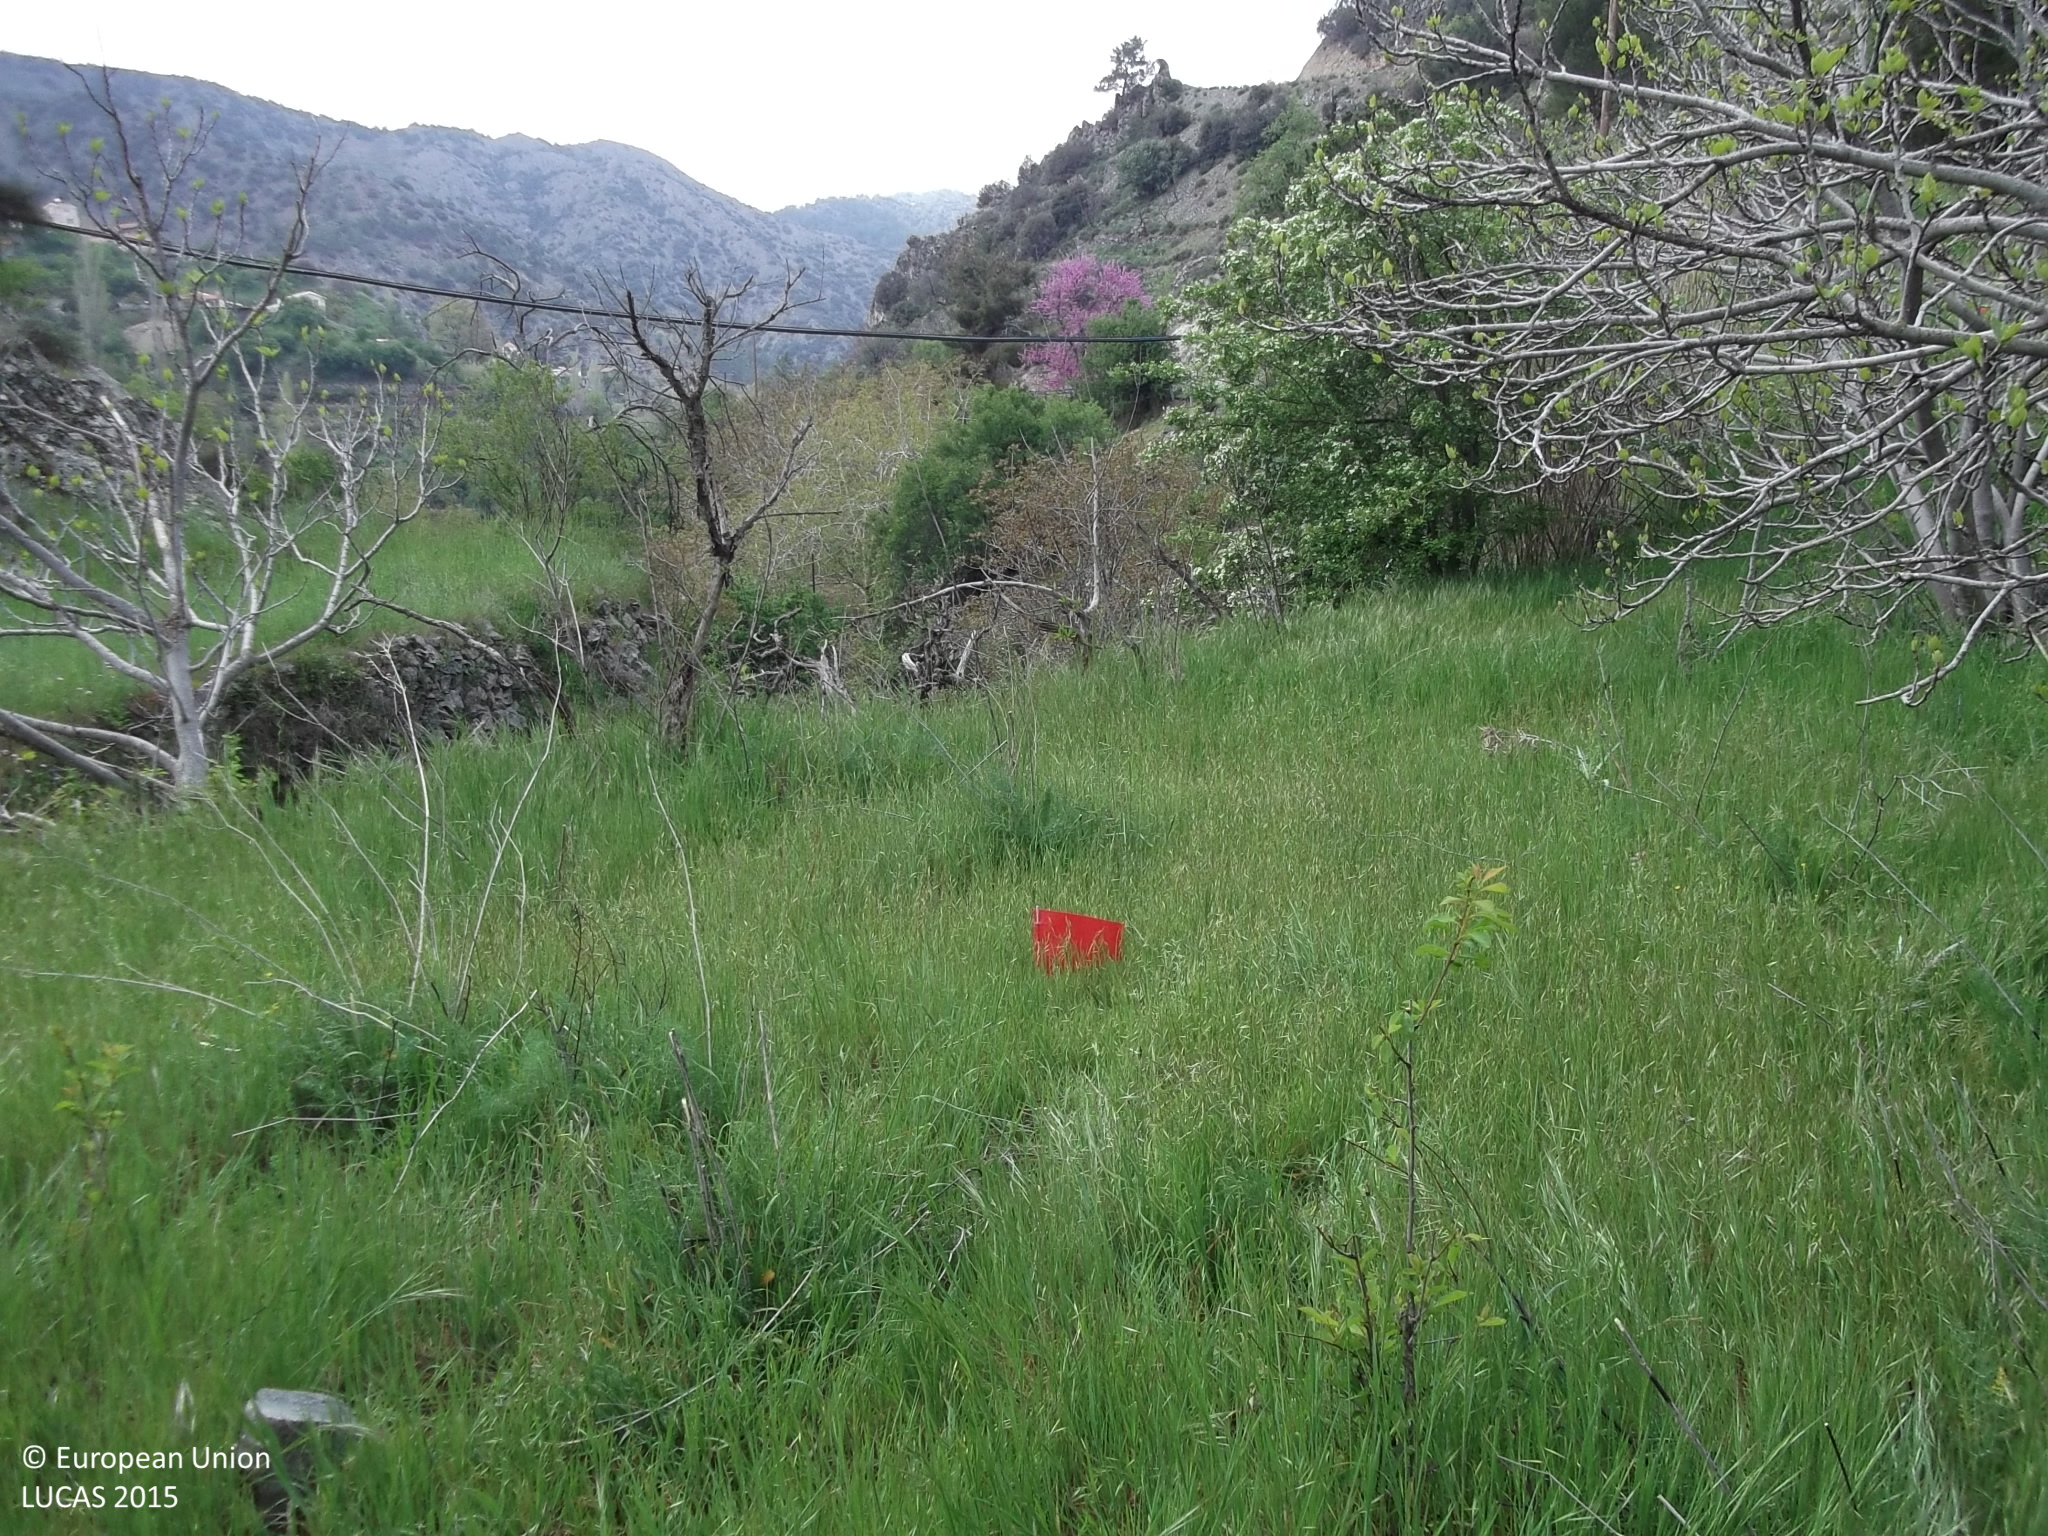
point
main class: Cropland
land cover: Other fruit trees and berries
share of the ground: 10 - 25 %
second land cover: Grassland without tree/shrub cover
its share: > 75 %
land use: Agriculture (excluding fallow land and kitchen gardens)
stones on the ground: 25 - 50 %
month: April
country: CY
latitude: 34.8983
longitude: 33.0321
